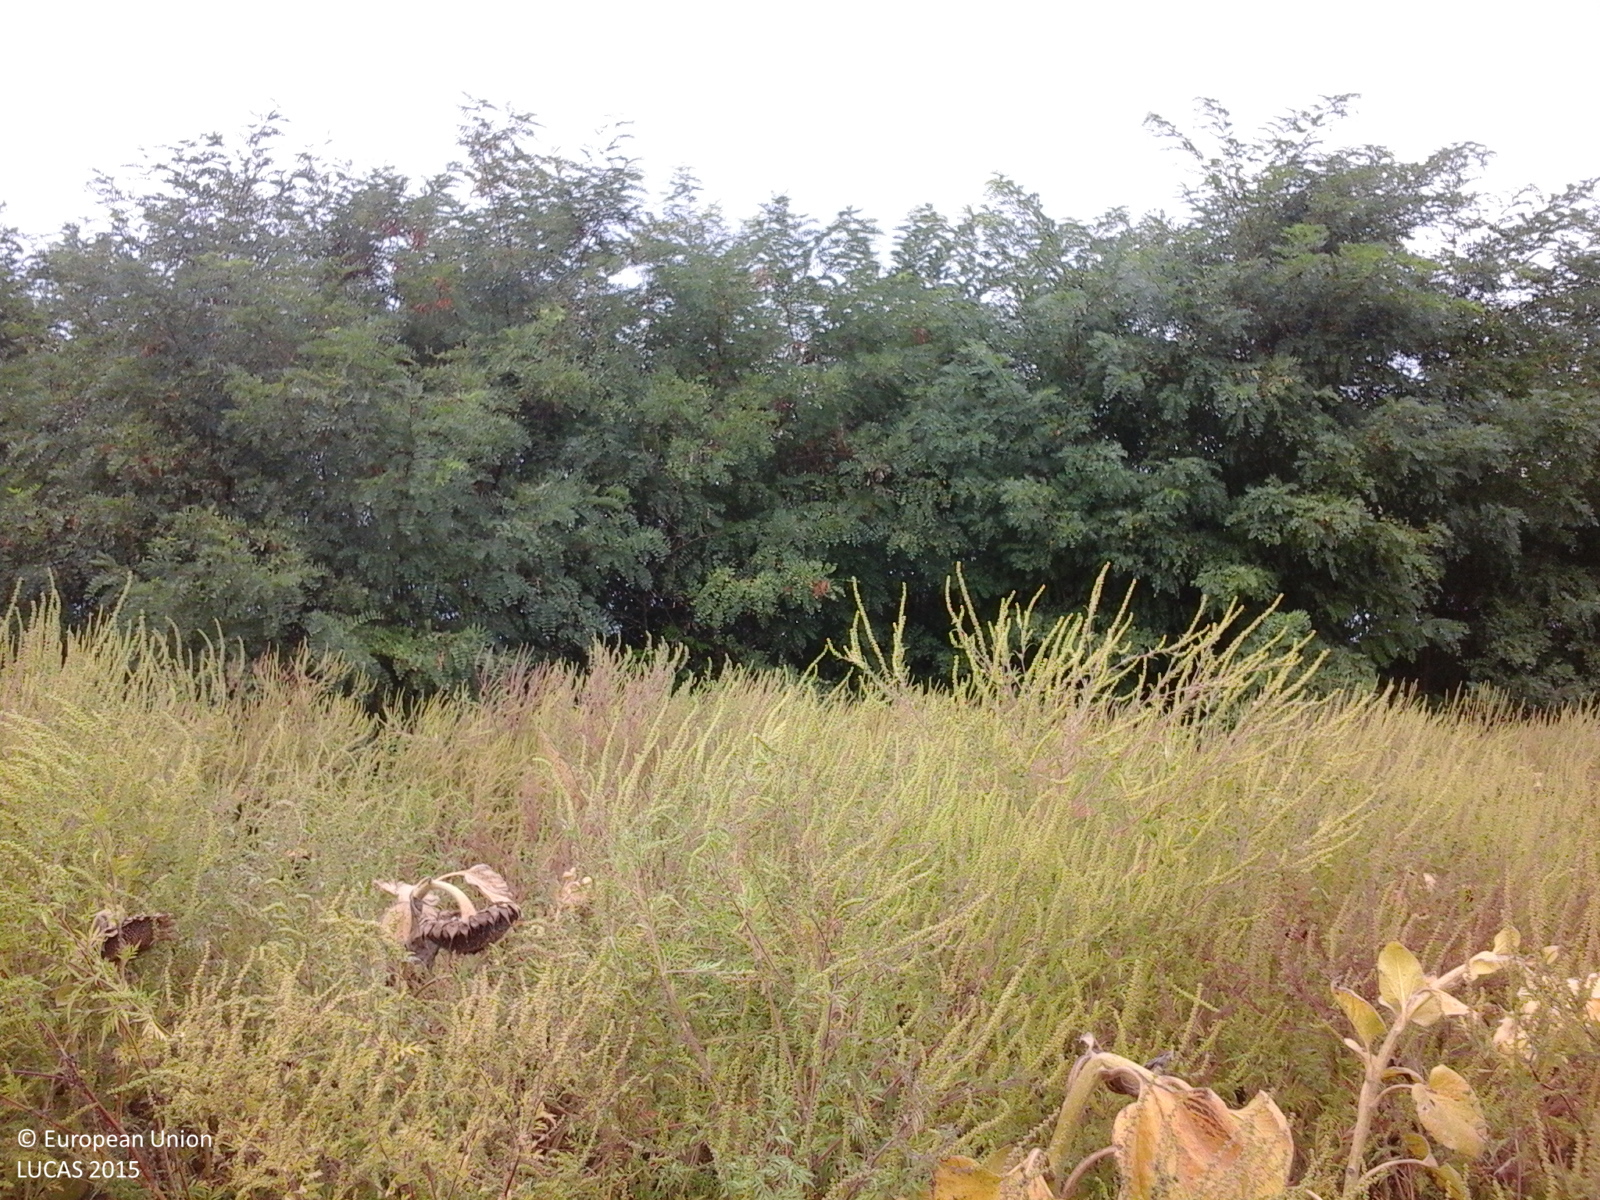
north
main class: Cropland
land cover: Sunflower
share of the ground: 50 - 75 %
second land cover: Spontaneously vegetated surfaces
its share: 25 - 50 %
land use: Agriculture (excluding fallow land and kitchen gardens)
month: September
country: RO
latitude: 47.5145
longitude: 22.6073
